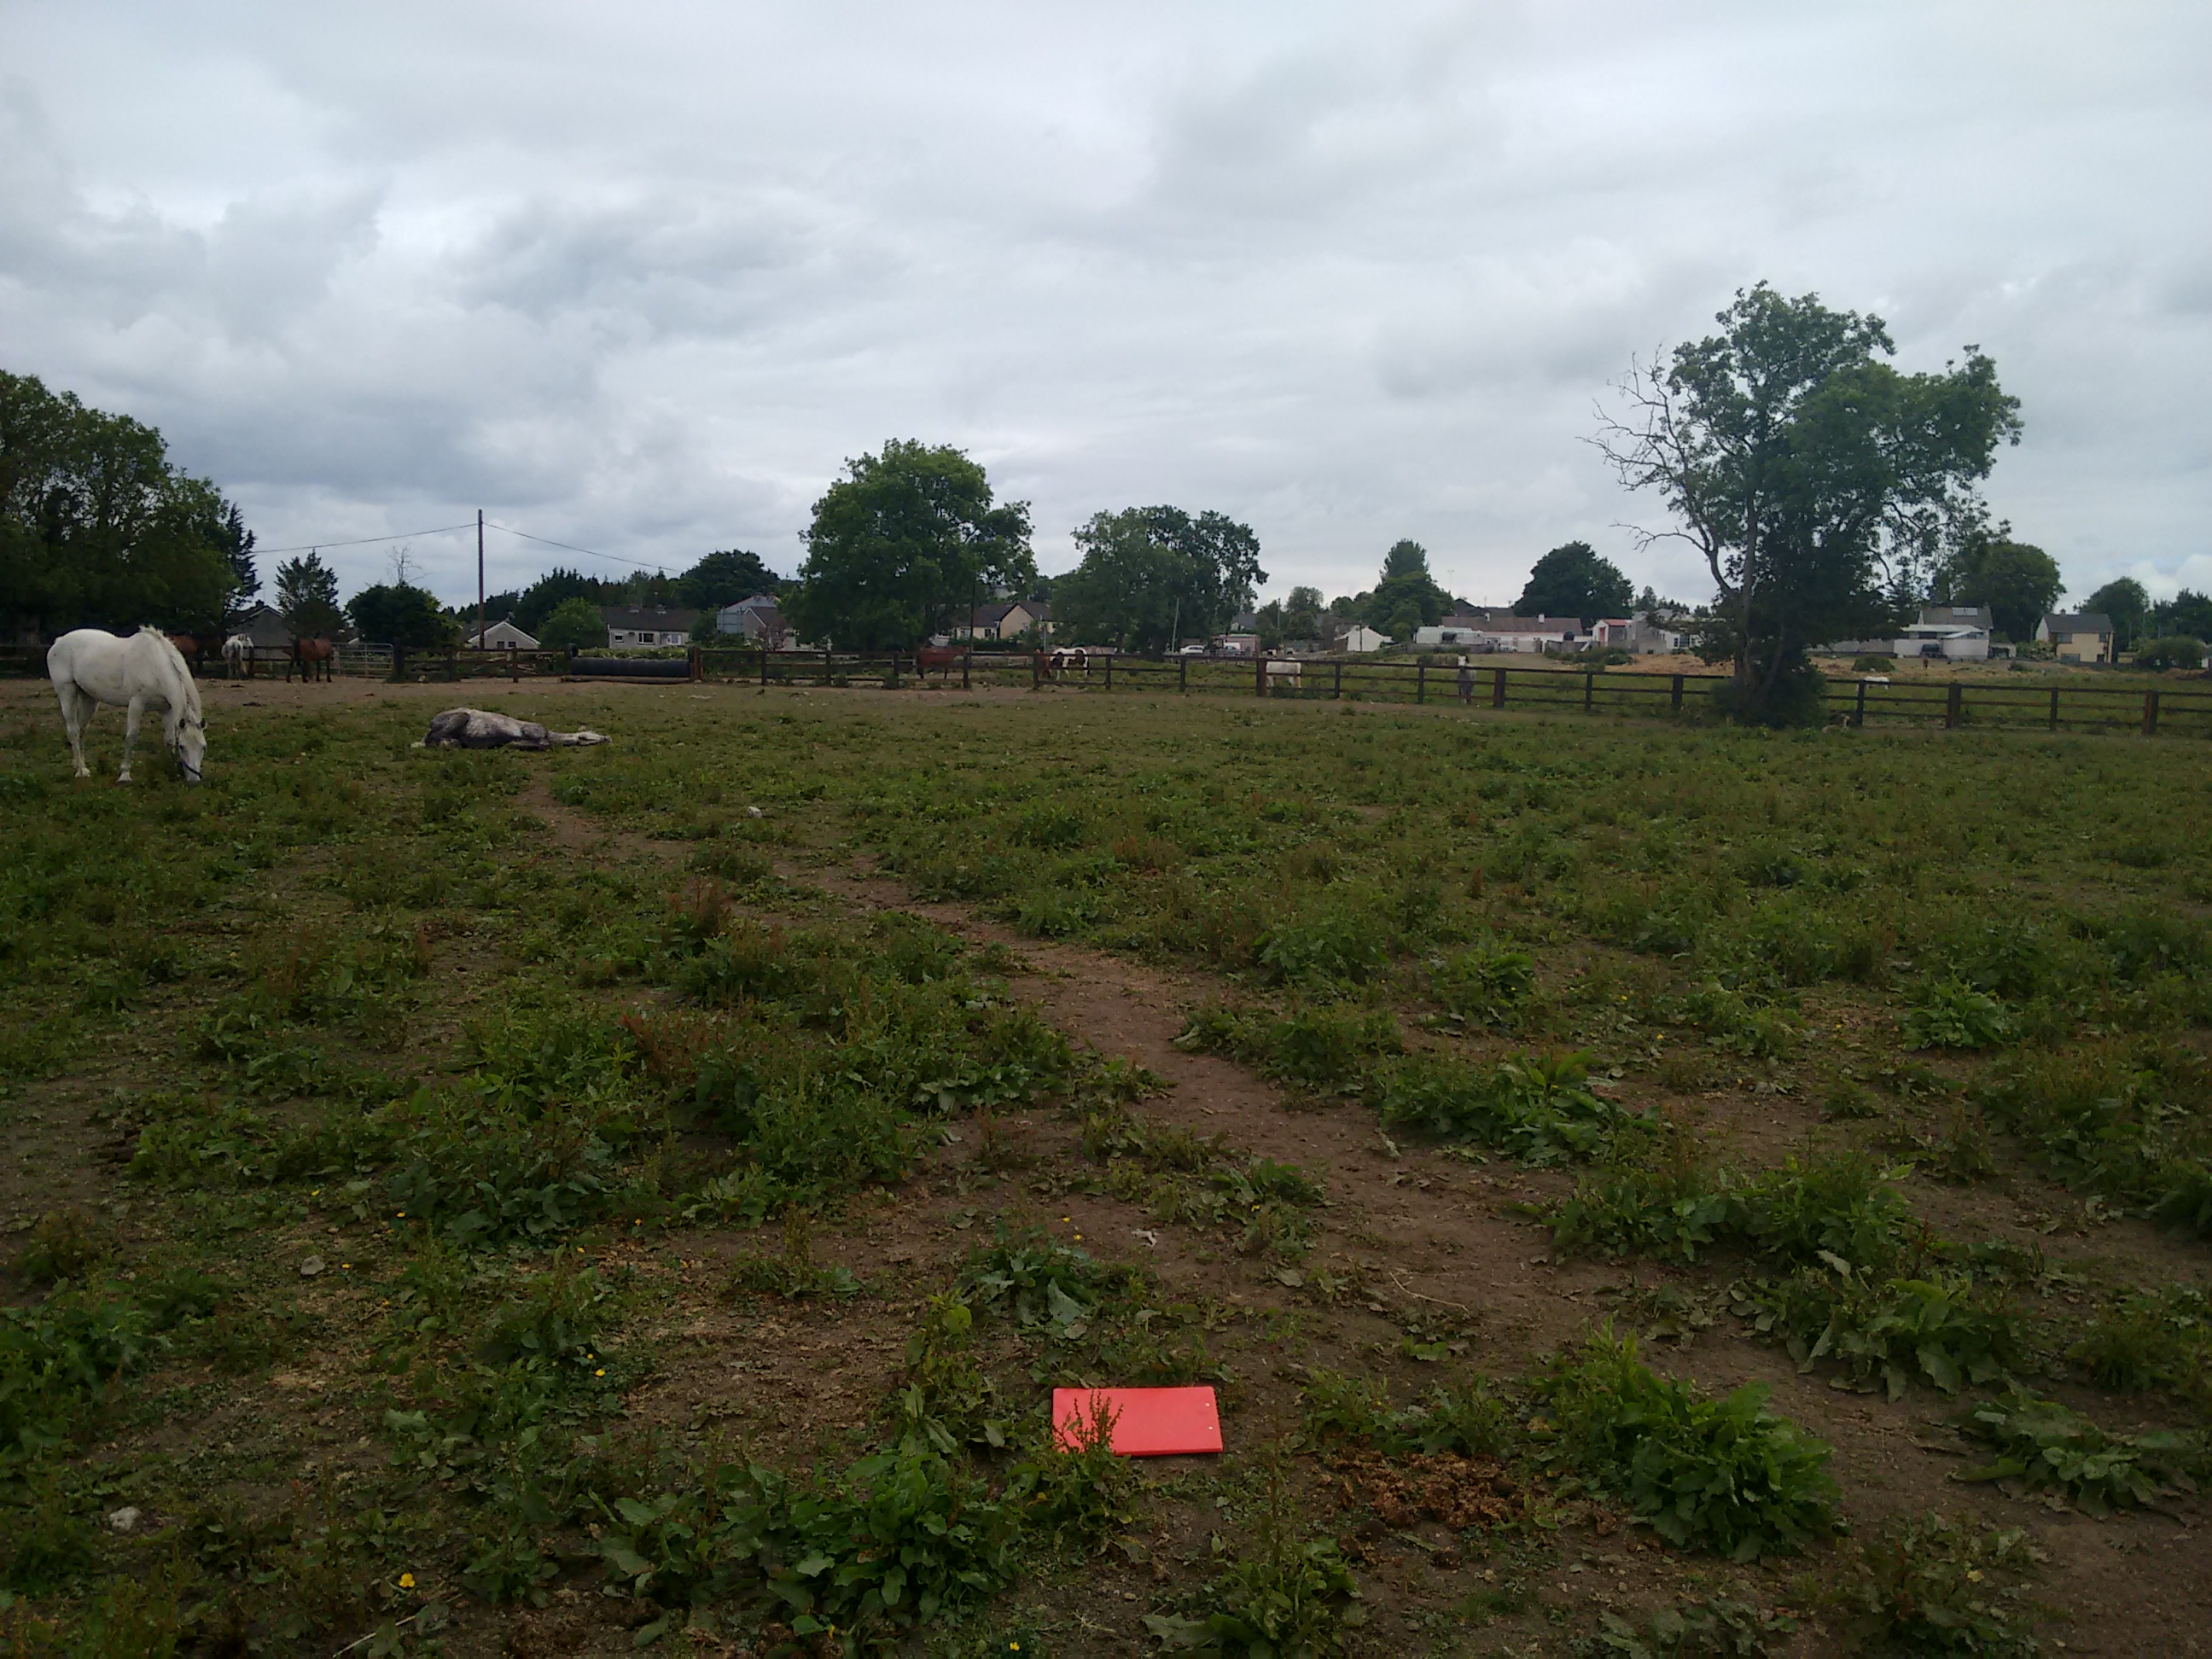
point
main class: Grassland
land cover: Spontaneously vegetated surfaces
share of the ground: > 75 %
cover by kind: herbaceous plants 50 %, consolidated bare surface 45 %, shrubs 5 %
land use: Agriculture (excluding fallow land and kitchen gardens)
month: June
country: IE
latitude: 53.4154
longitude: -7.9108
